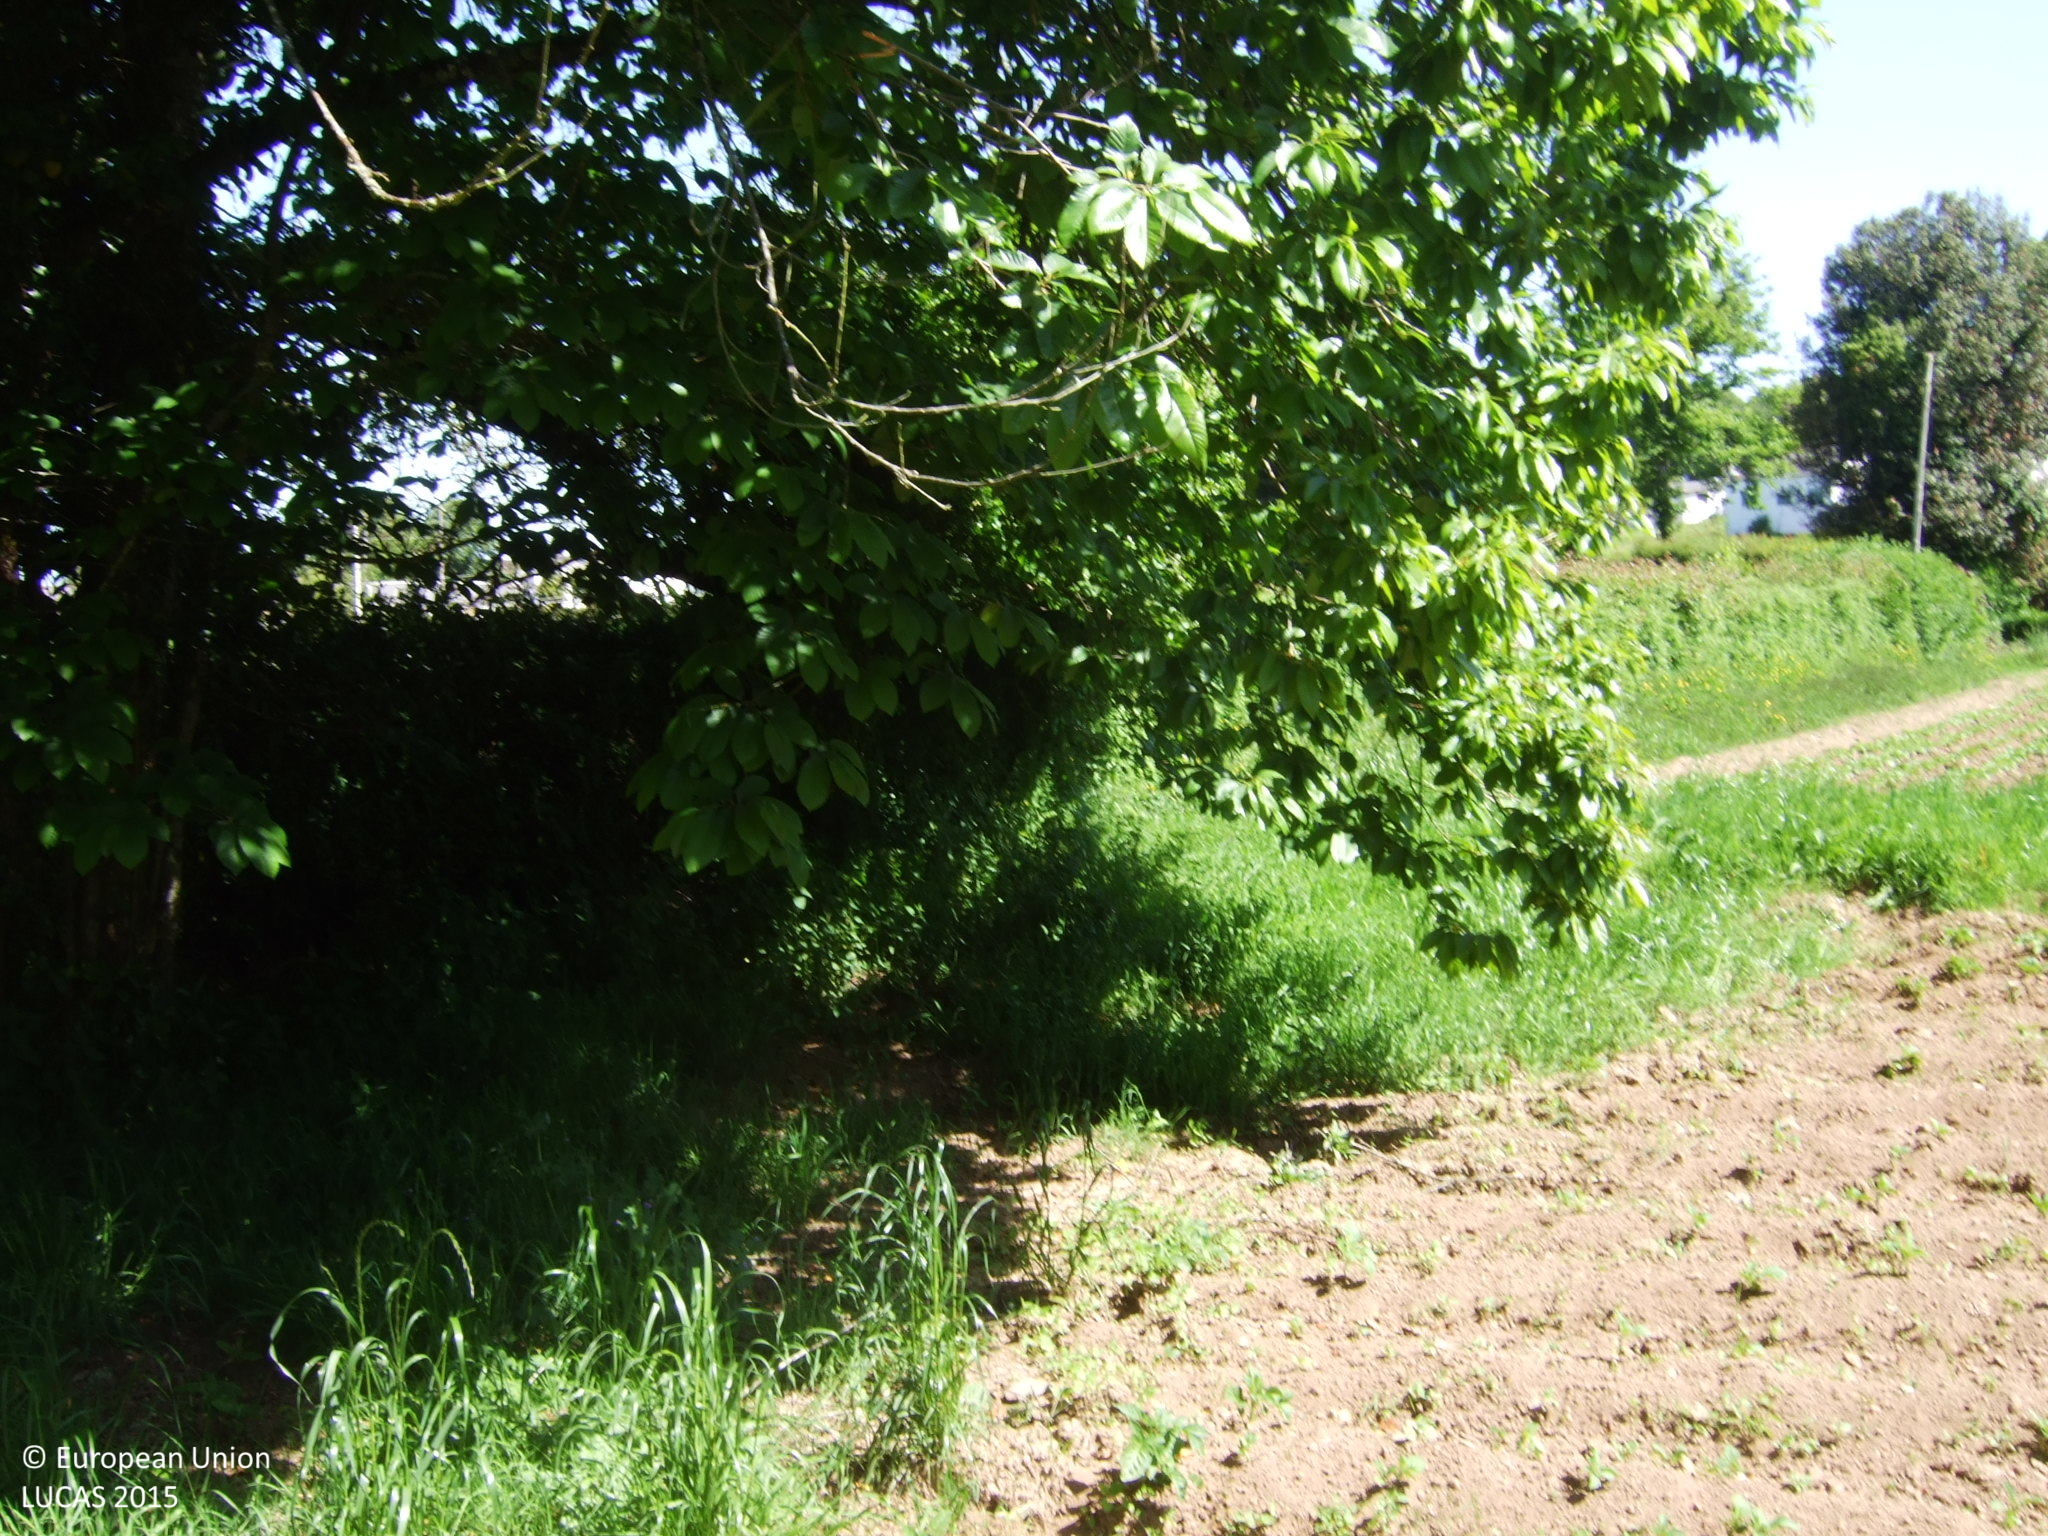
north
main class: Cropland
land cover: Potatoes
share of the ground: < 10 %
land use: Agriculture (excluding fallow land and kitchen gardens)
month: May
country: ES
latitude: 43.1496
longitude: -7.6788
